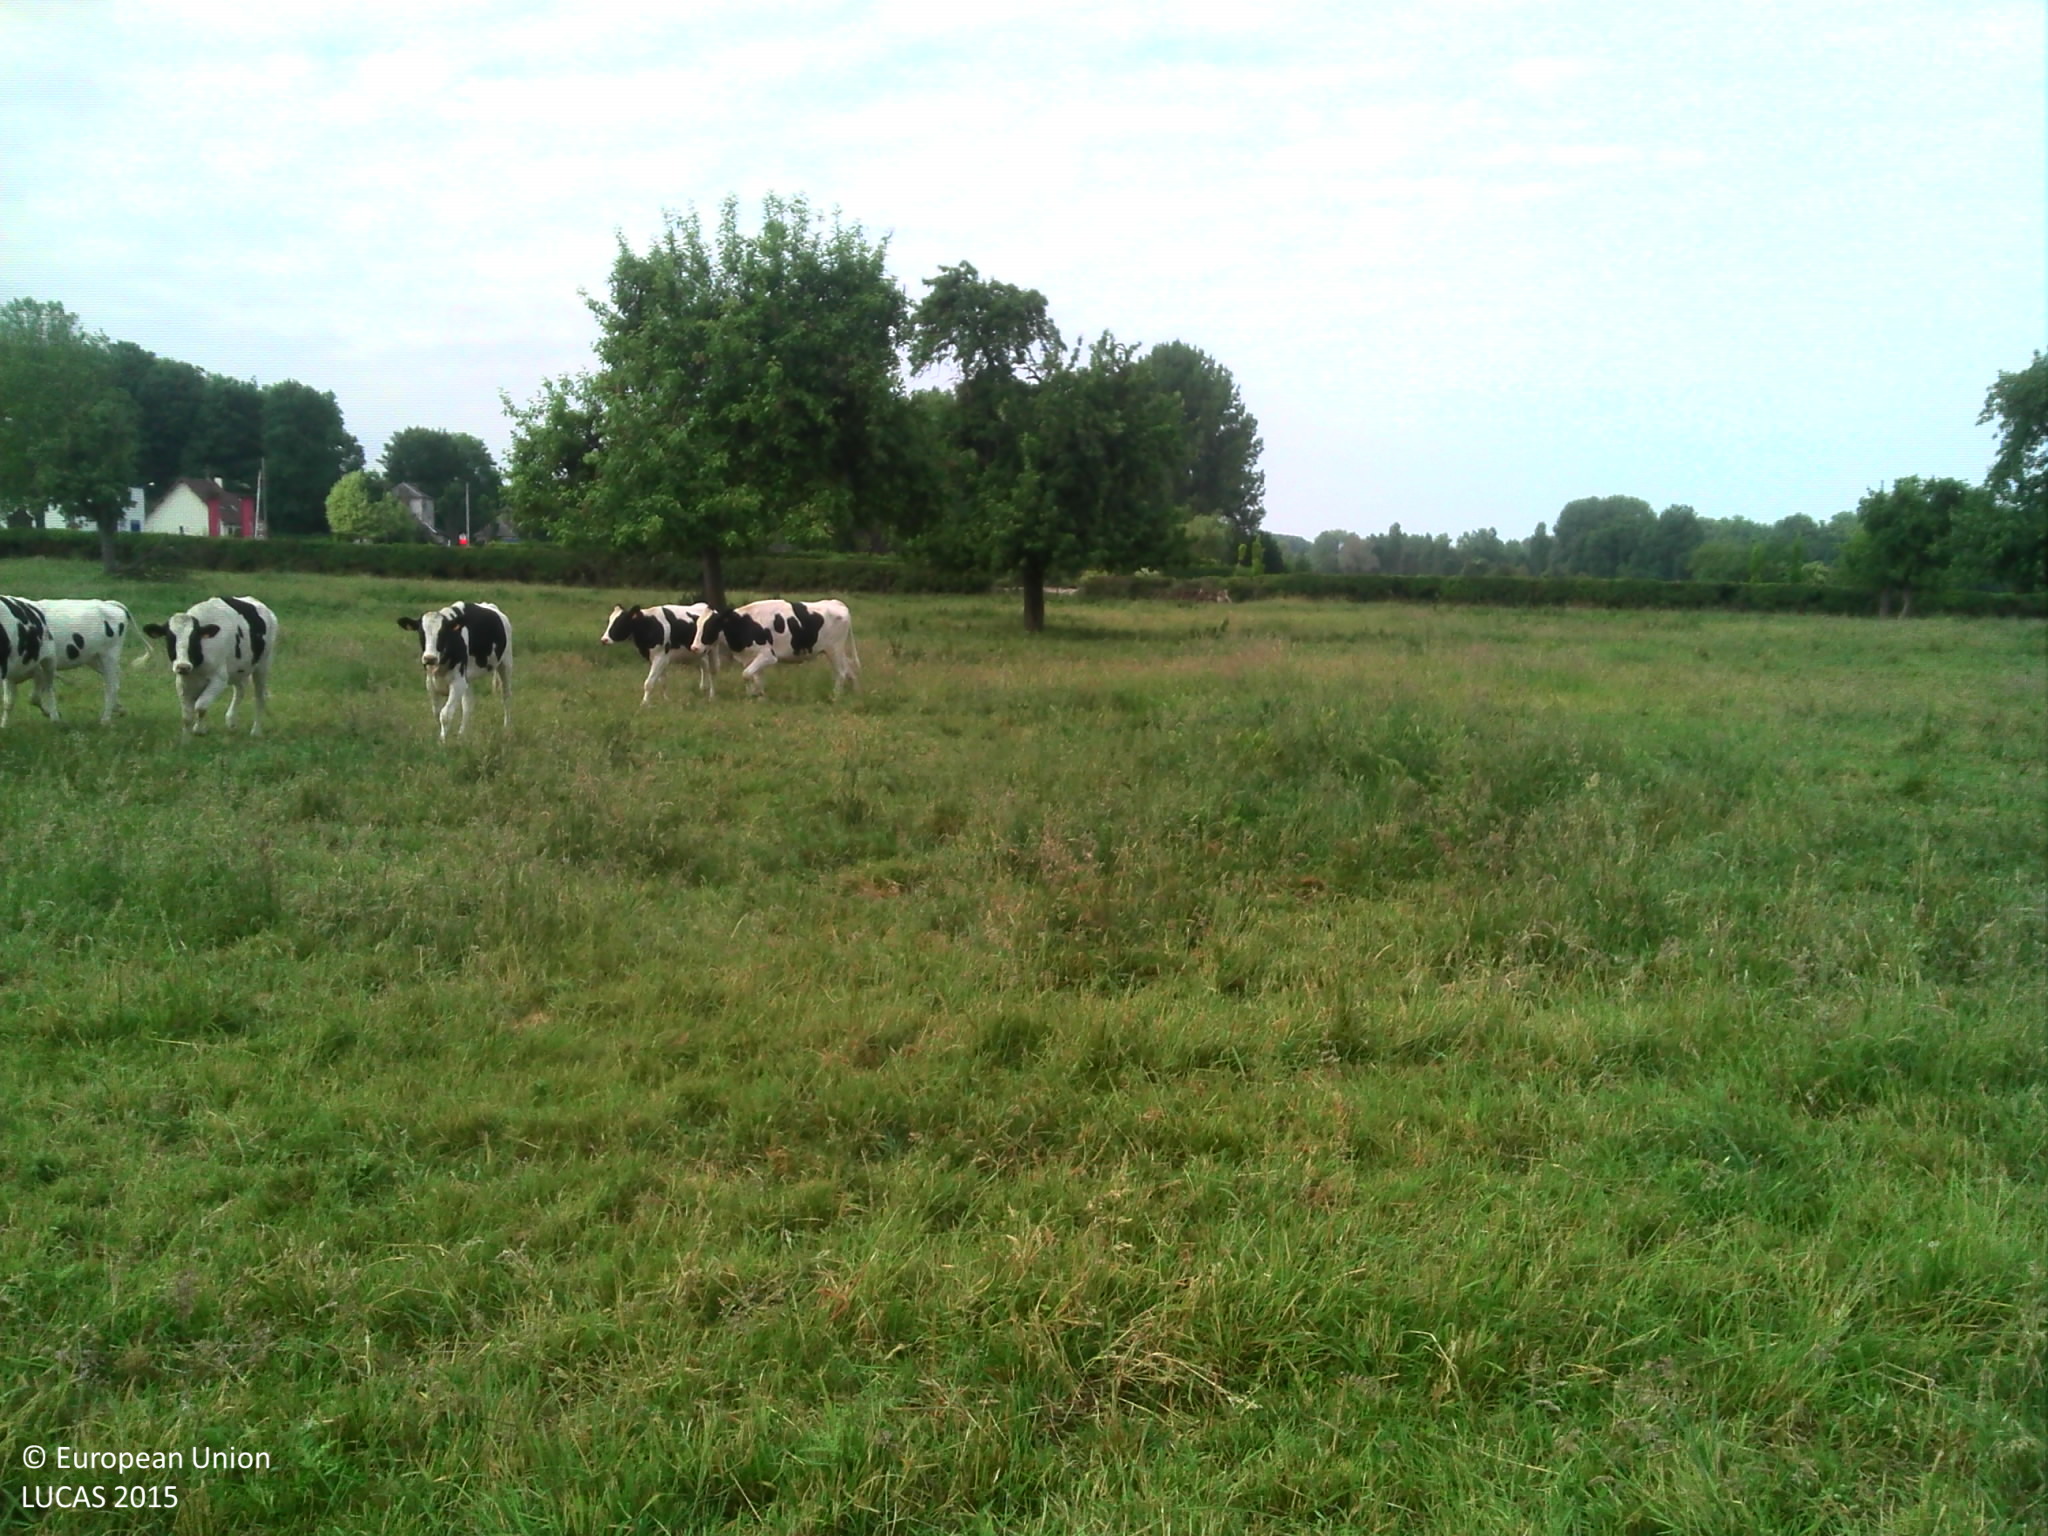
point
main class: Grassland
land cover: Grassland with sparse tree/shrub cover
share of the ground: > 75 %
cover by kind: herbaceous plants 95 %, broadleaved forest trees 5 %
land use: Agriculture (excluding fallow land and kitchen gardens)
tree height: > 5 m
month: June
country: FR
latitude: 49.7655
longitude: 2.3650
